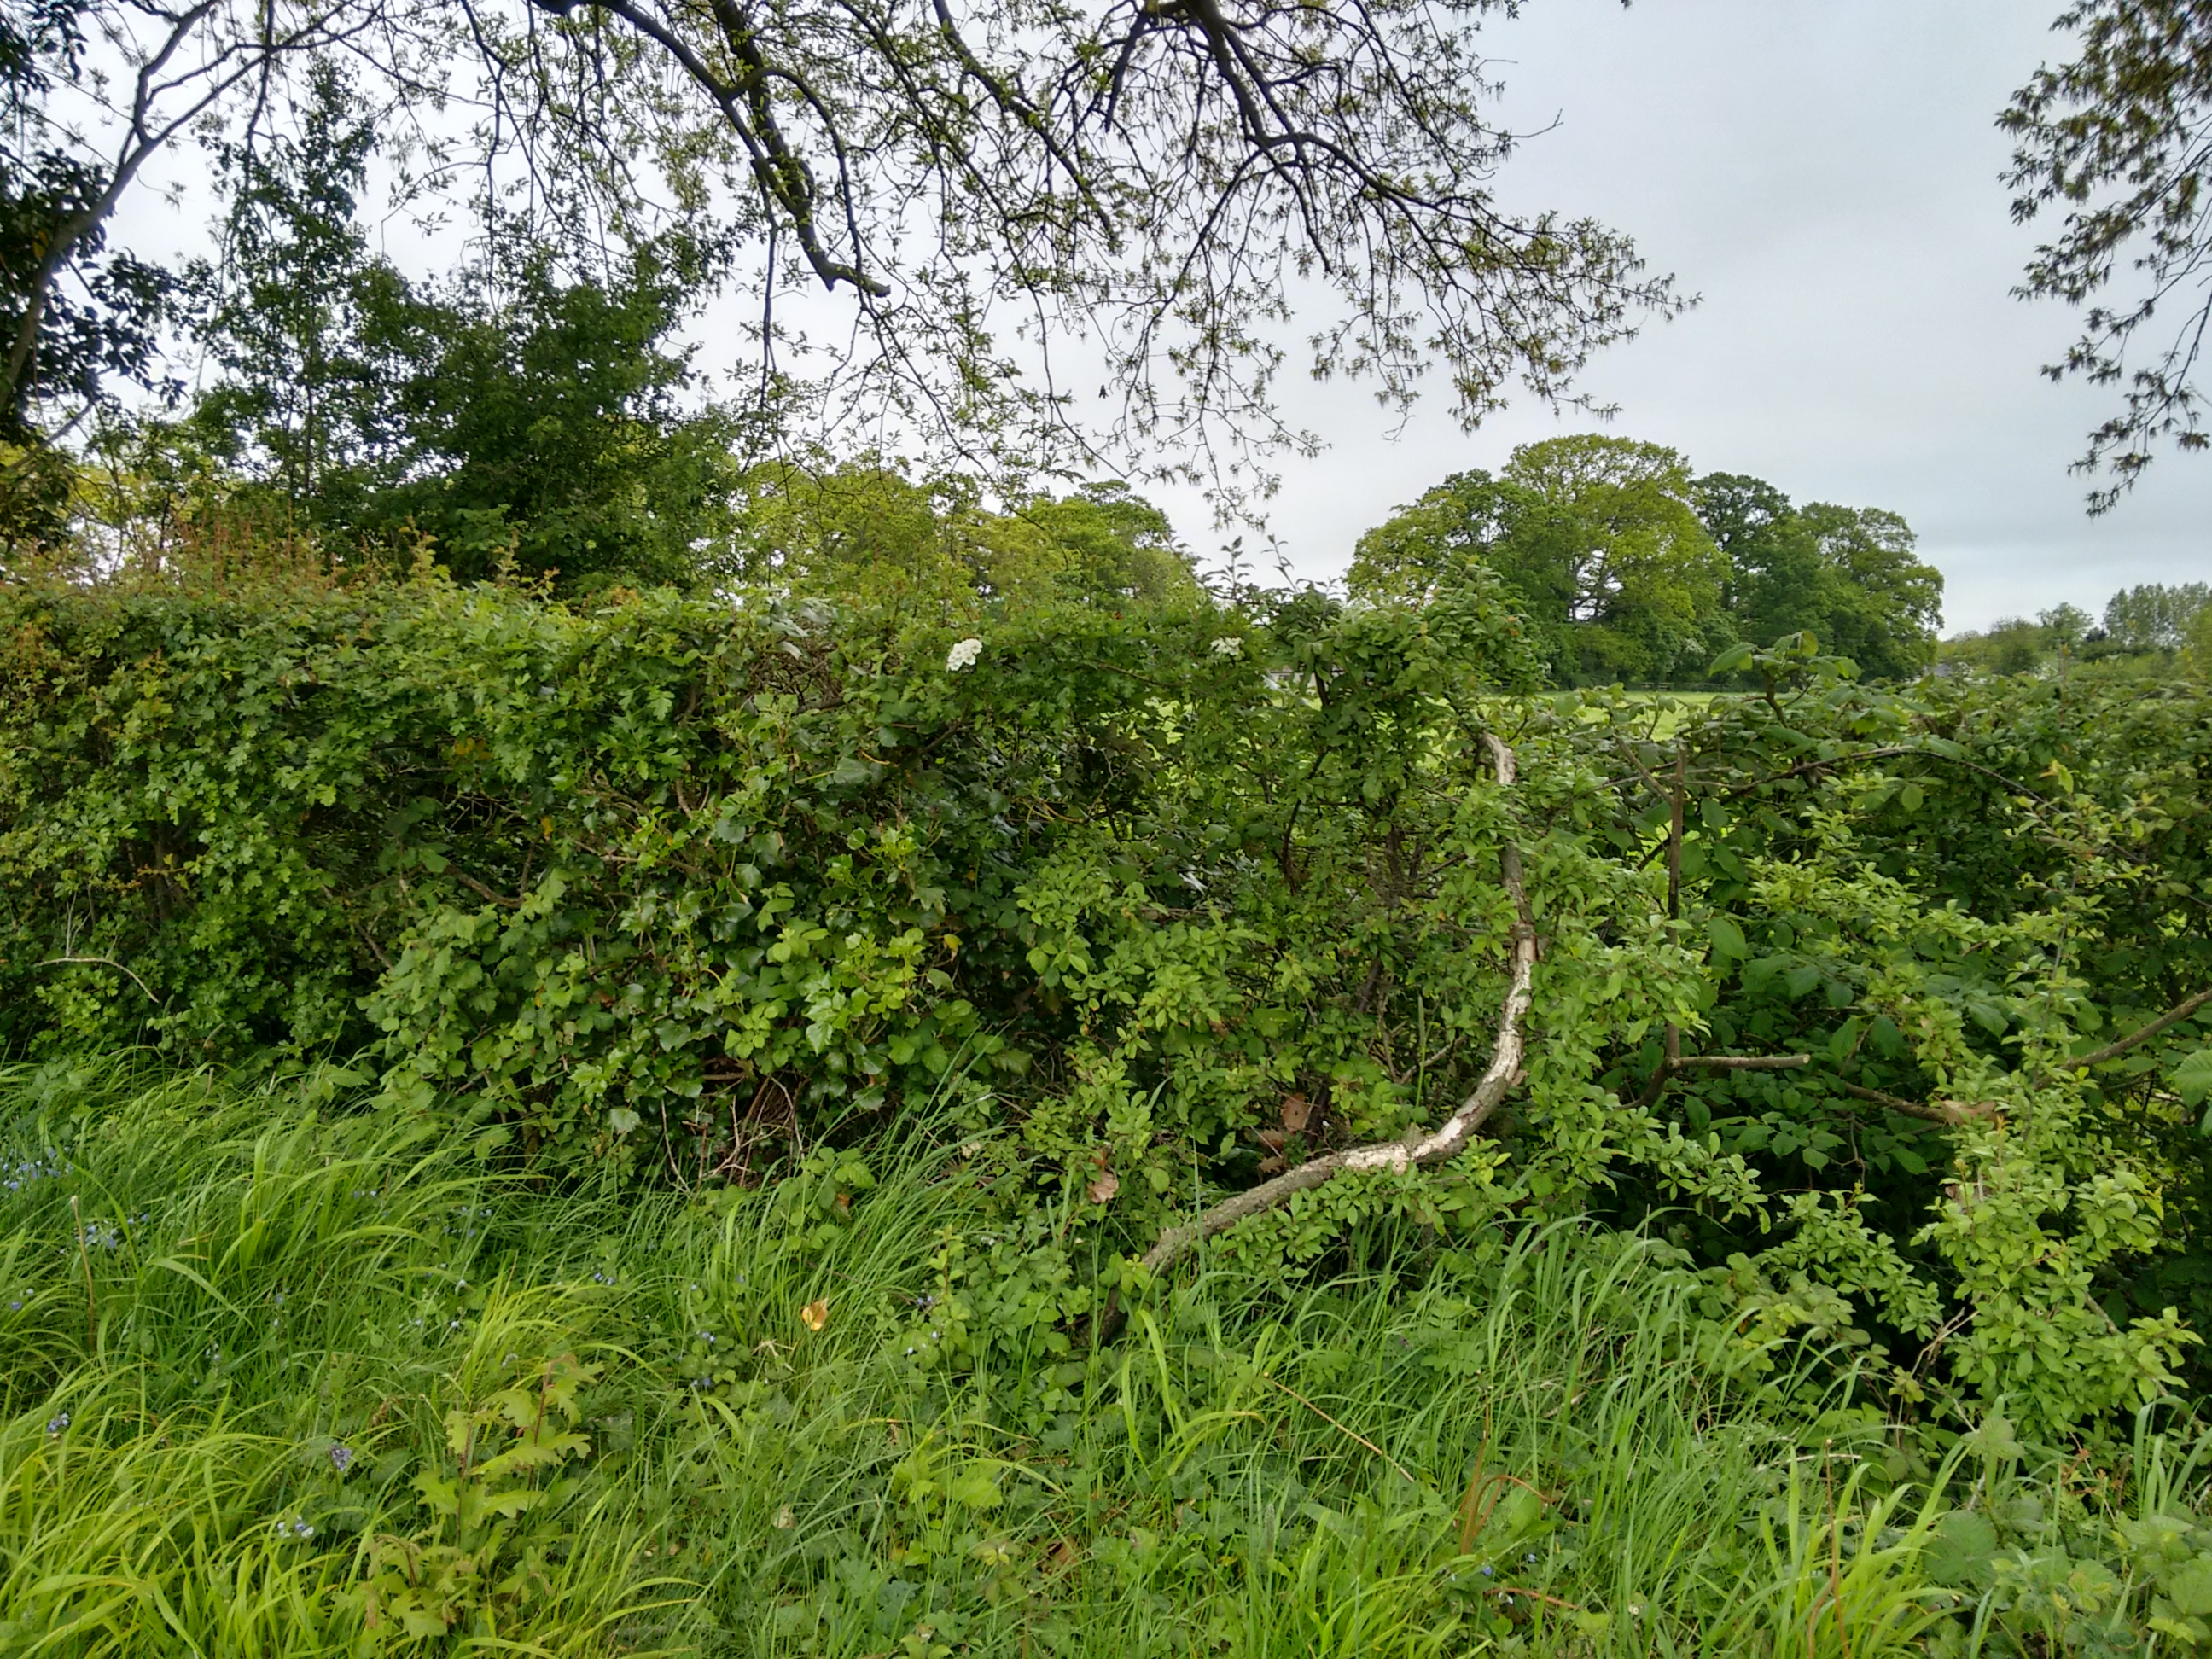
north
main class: Cropland
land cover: Barley
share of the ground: 50 - 75 %
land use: Agriculture (excluding fallow land and kitchen gardens)
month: May
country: IE
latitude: 53.4014
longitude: -6.4751
